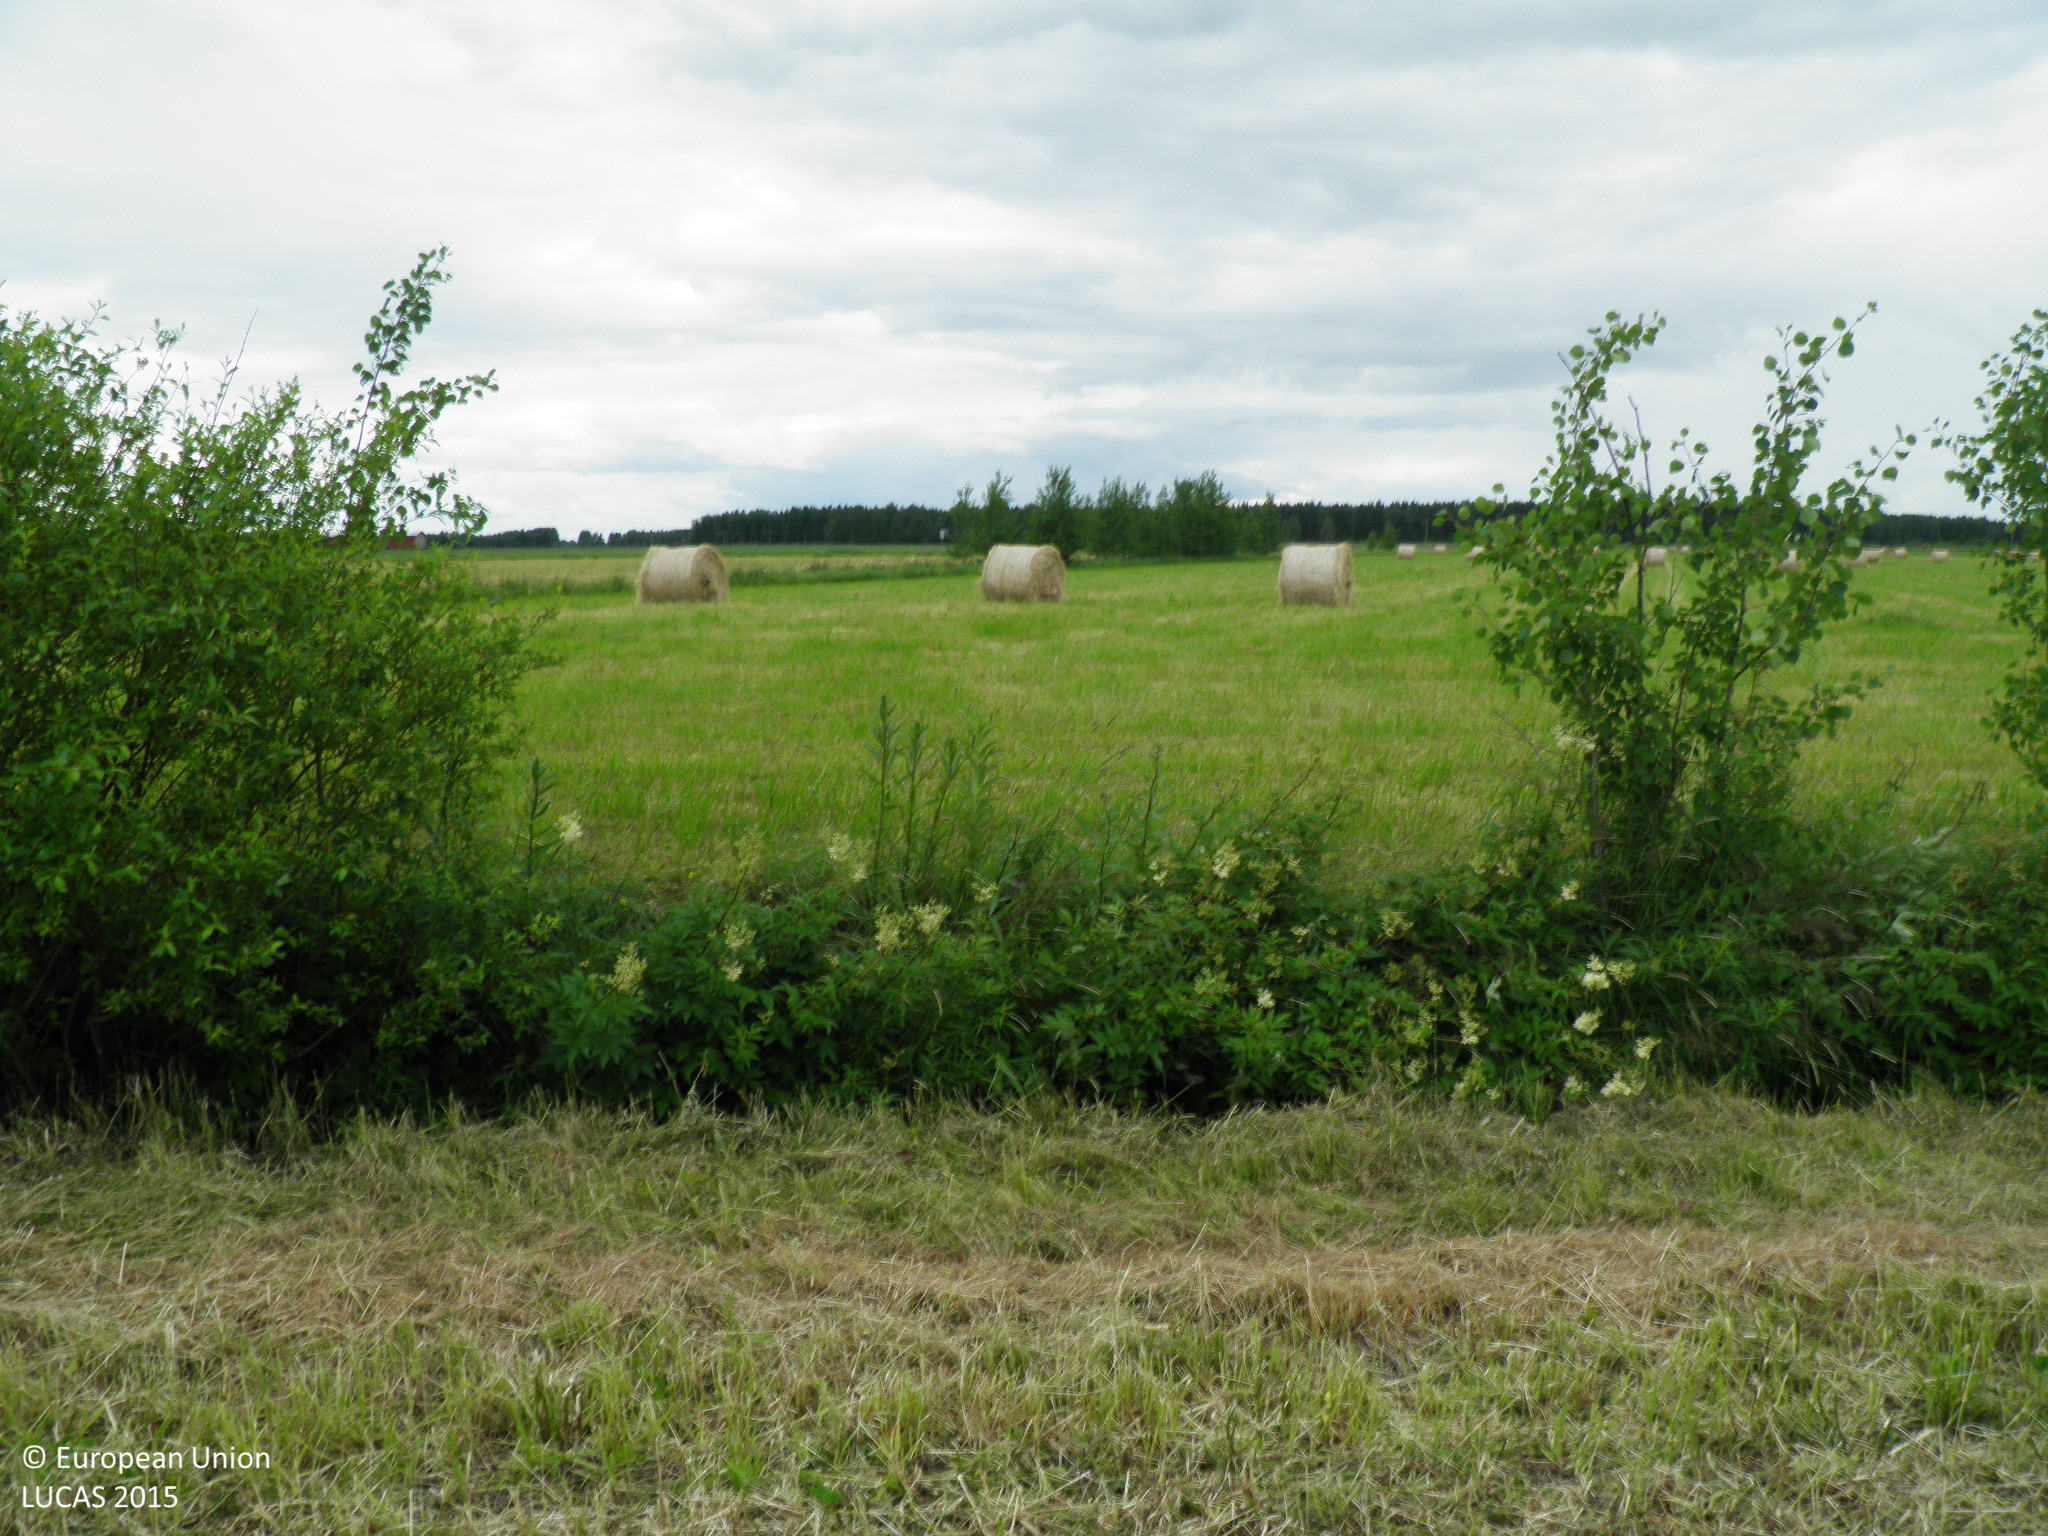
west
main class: Cropland
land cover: Temporary grasslands
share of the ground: < 10 %
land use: Agriculture (excluding fallow land and kitchen gardens)
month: July
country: FI
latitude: 60.8158
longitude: 23.0376
